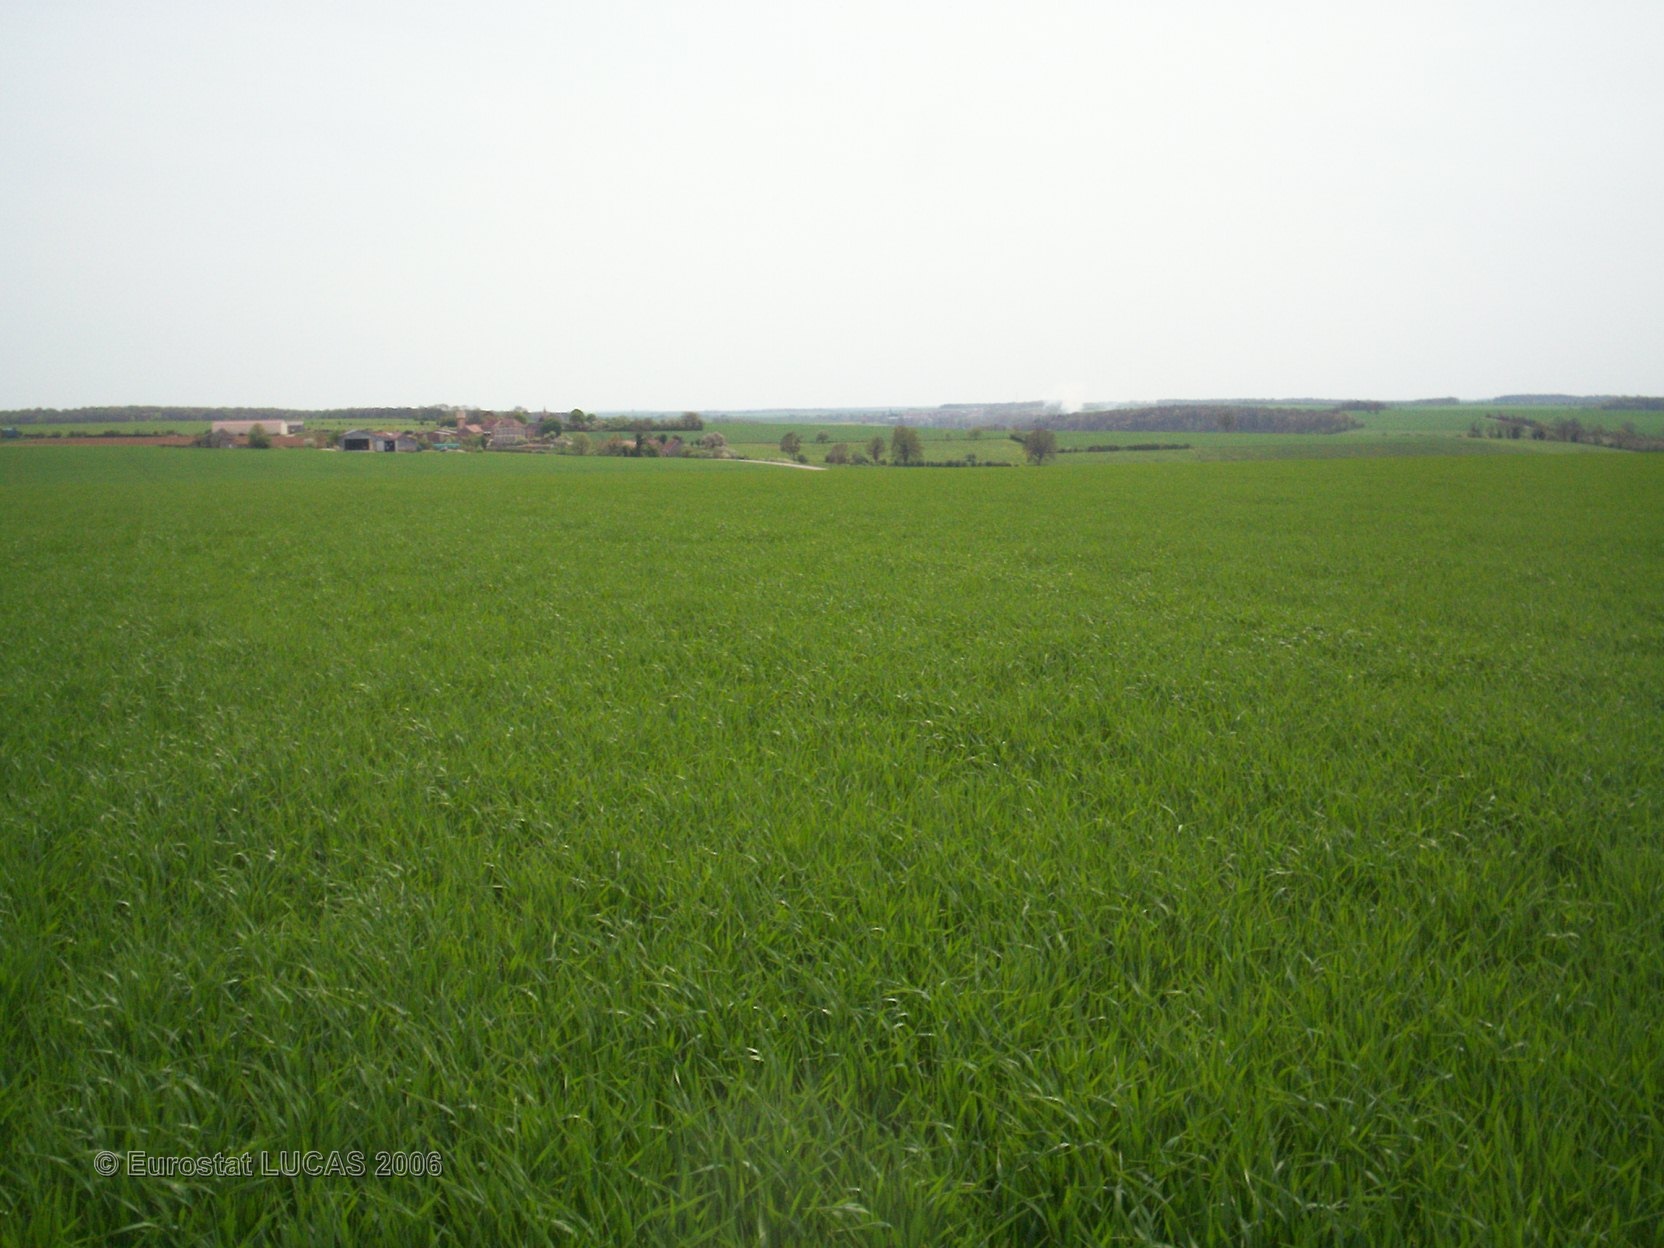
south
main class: Cropland
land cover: Barley
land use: Agriculture (excluding fallow land and kitchen gardens)
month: May
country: FR
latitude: 47.6420
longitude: 4.6347
